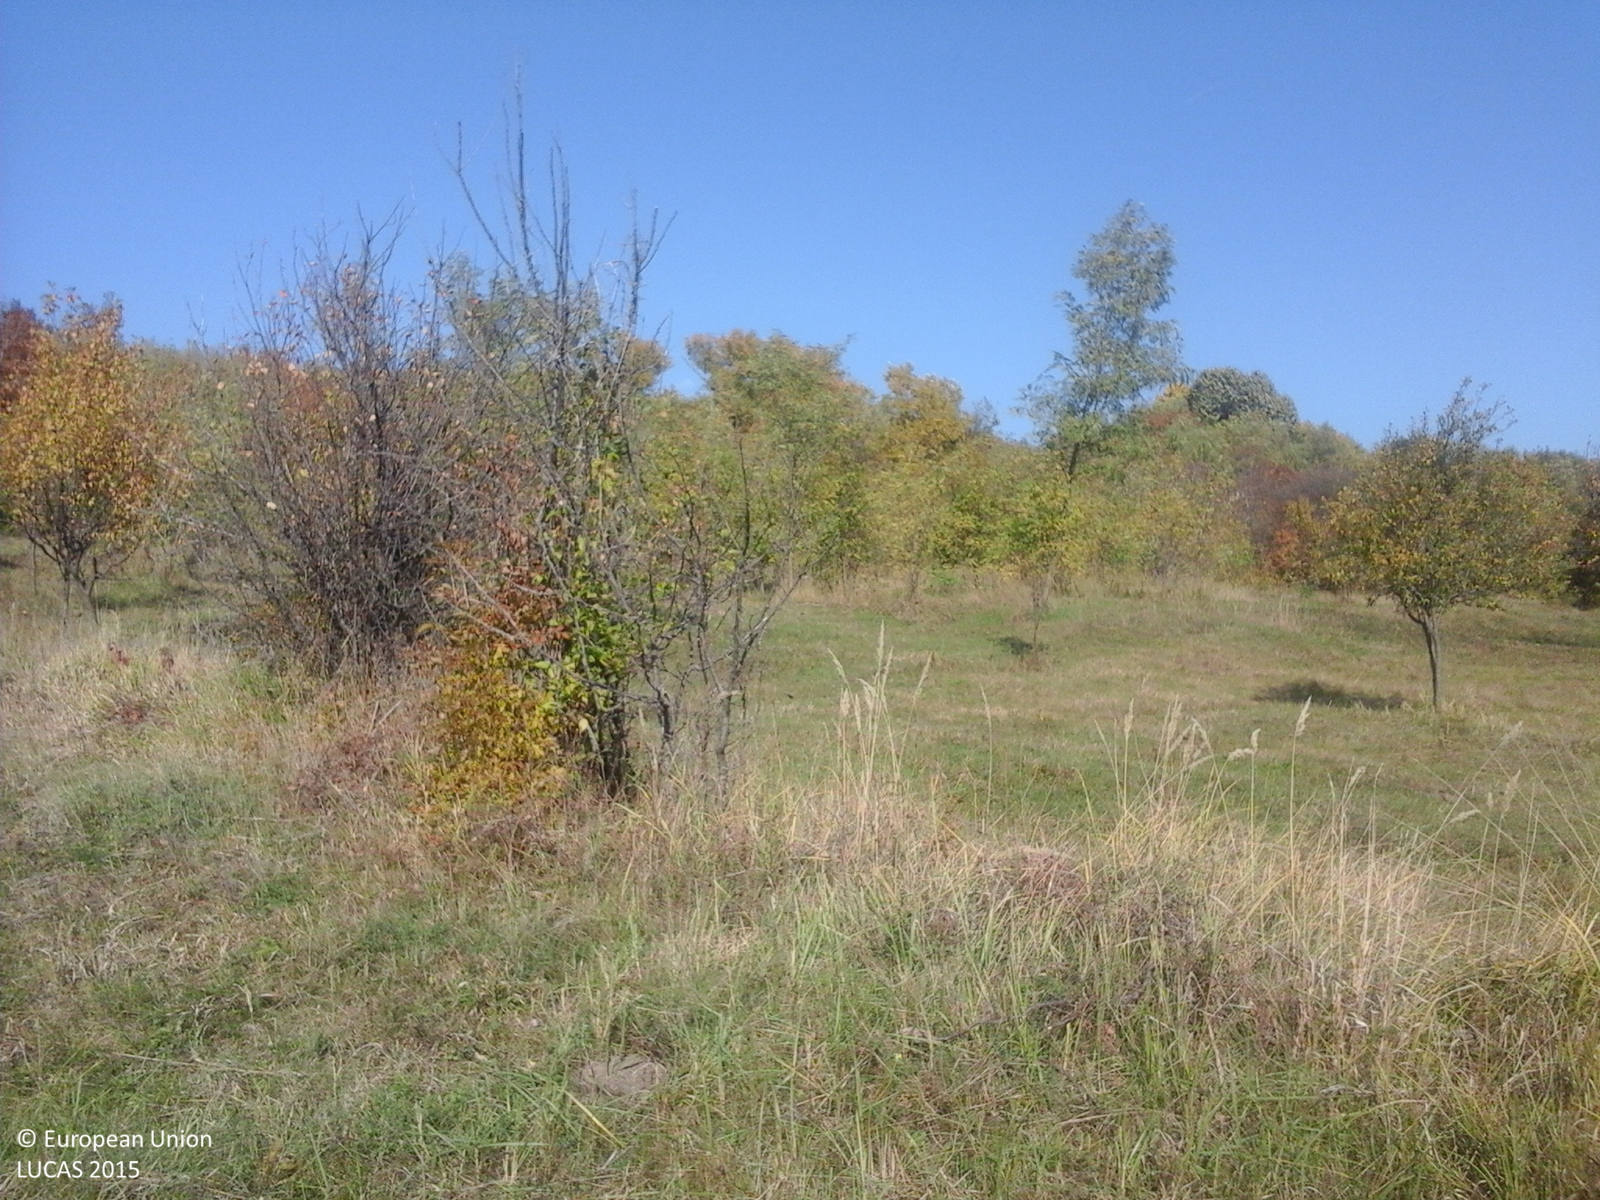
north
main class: Cropland
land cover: Other fruit trees and berries
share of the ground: > 75 %
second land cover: Grassland without tree/shrub cover
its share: > 75 %
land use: Agriculture (excluding fallow land and kitchen gardens)
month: October
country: RO
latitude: 45.3053
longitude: 26.5650
